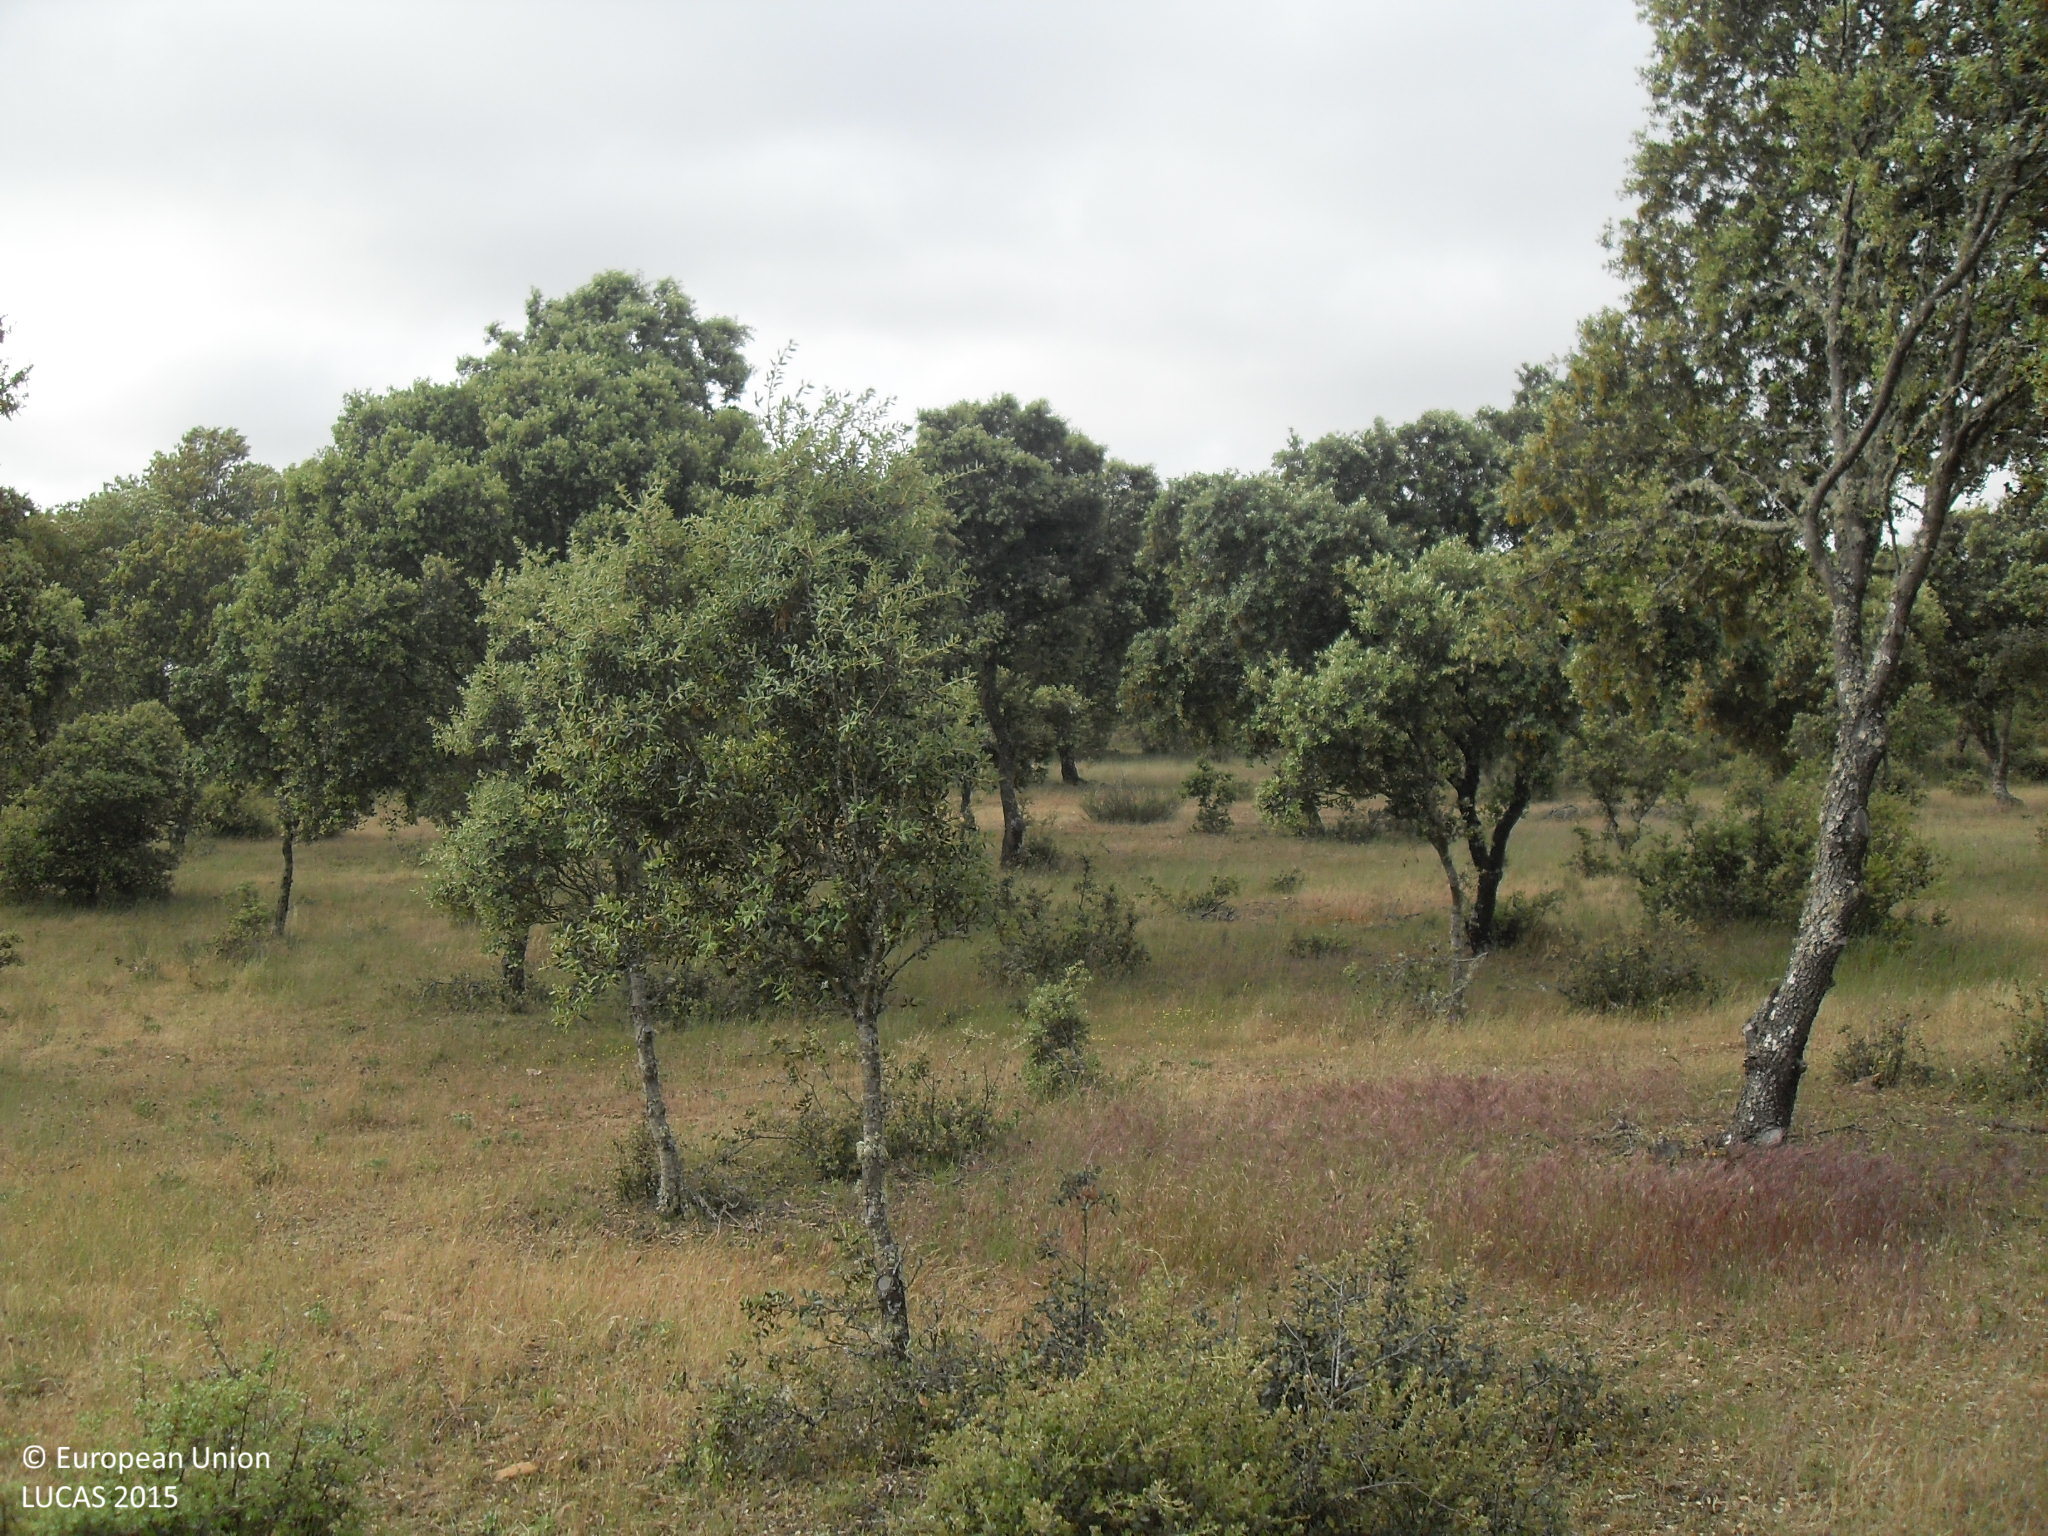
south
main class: Woodland
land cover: Broadleaved woodland
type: broadleaved evergreen forest
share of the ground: > 75 %
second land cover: Grassland without tree/shrub cover
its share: 10 - 25 %
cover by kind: broadleaved forest trees 80 %, herbaceous plants 20 %
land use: Forestry
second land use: Agriculture (excluding fallow land and kitchen gardens)
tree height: > 5 m
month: May
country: ES
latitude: 40.7317
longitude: -5.6438
